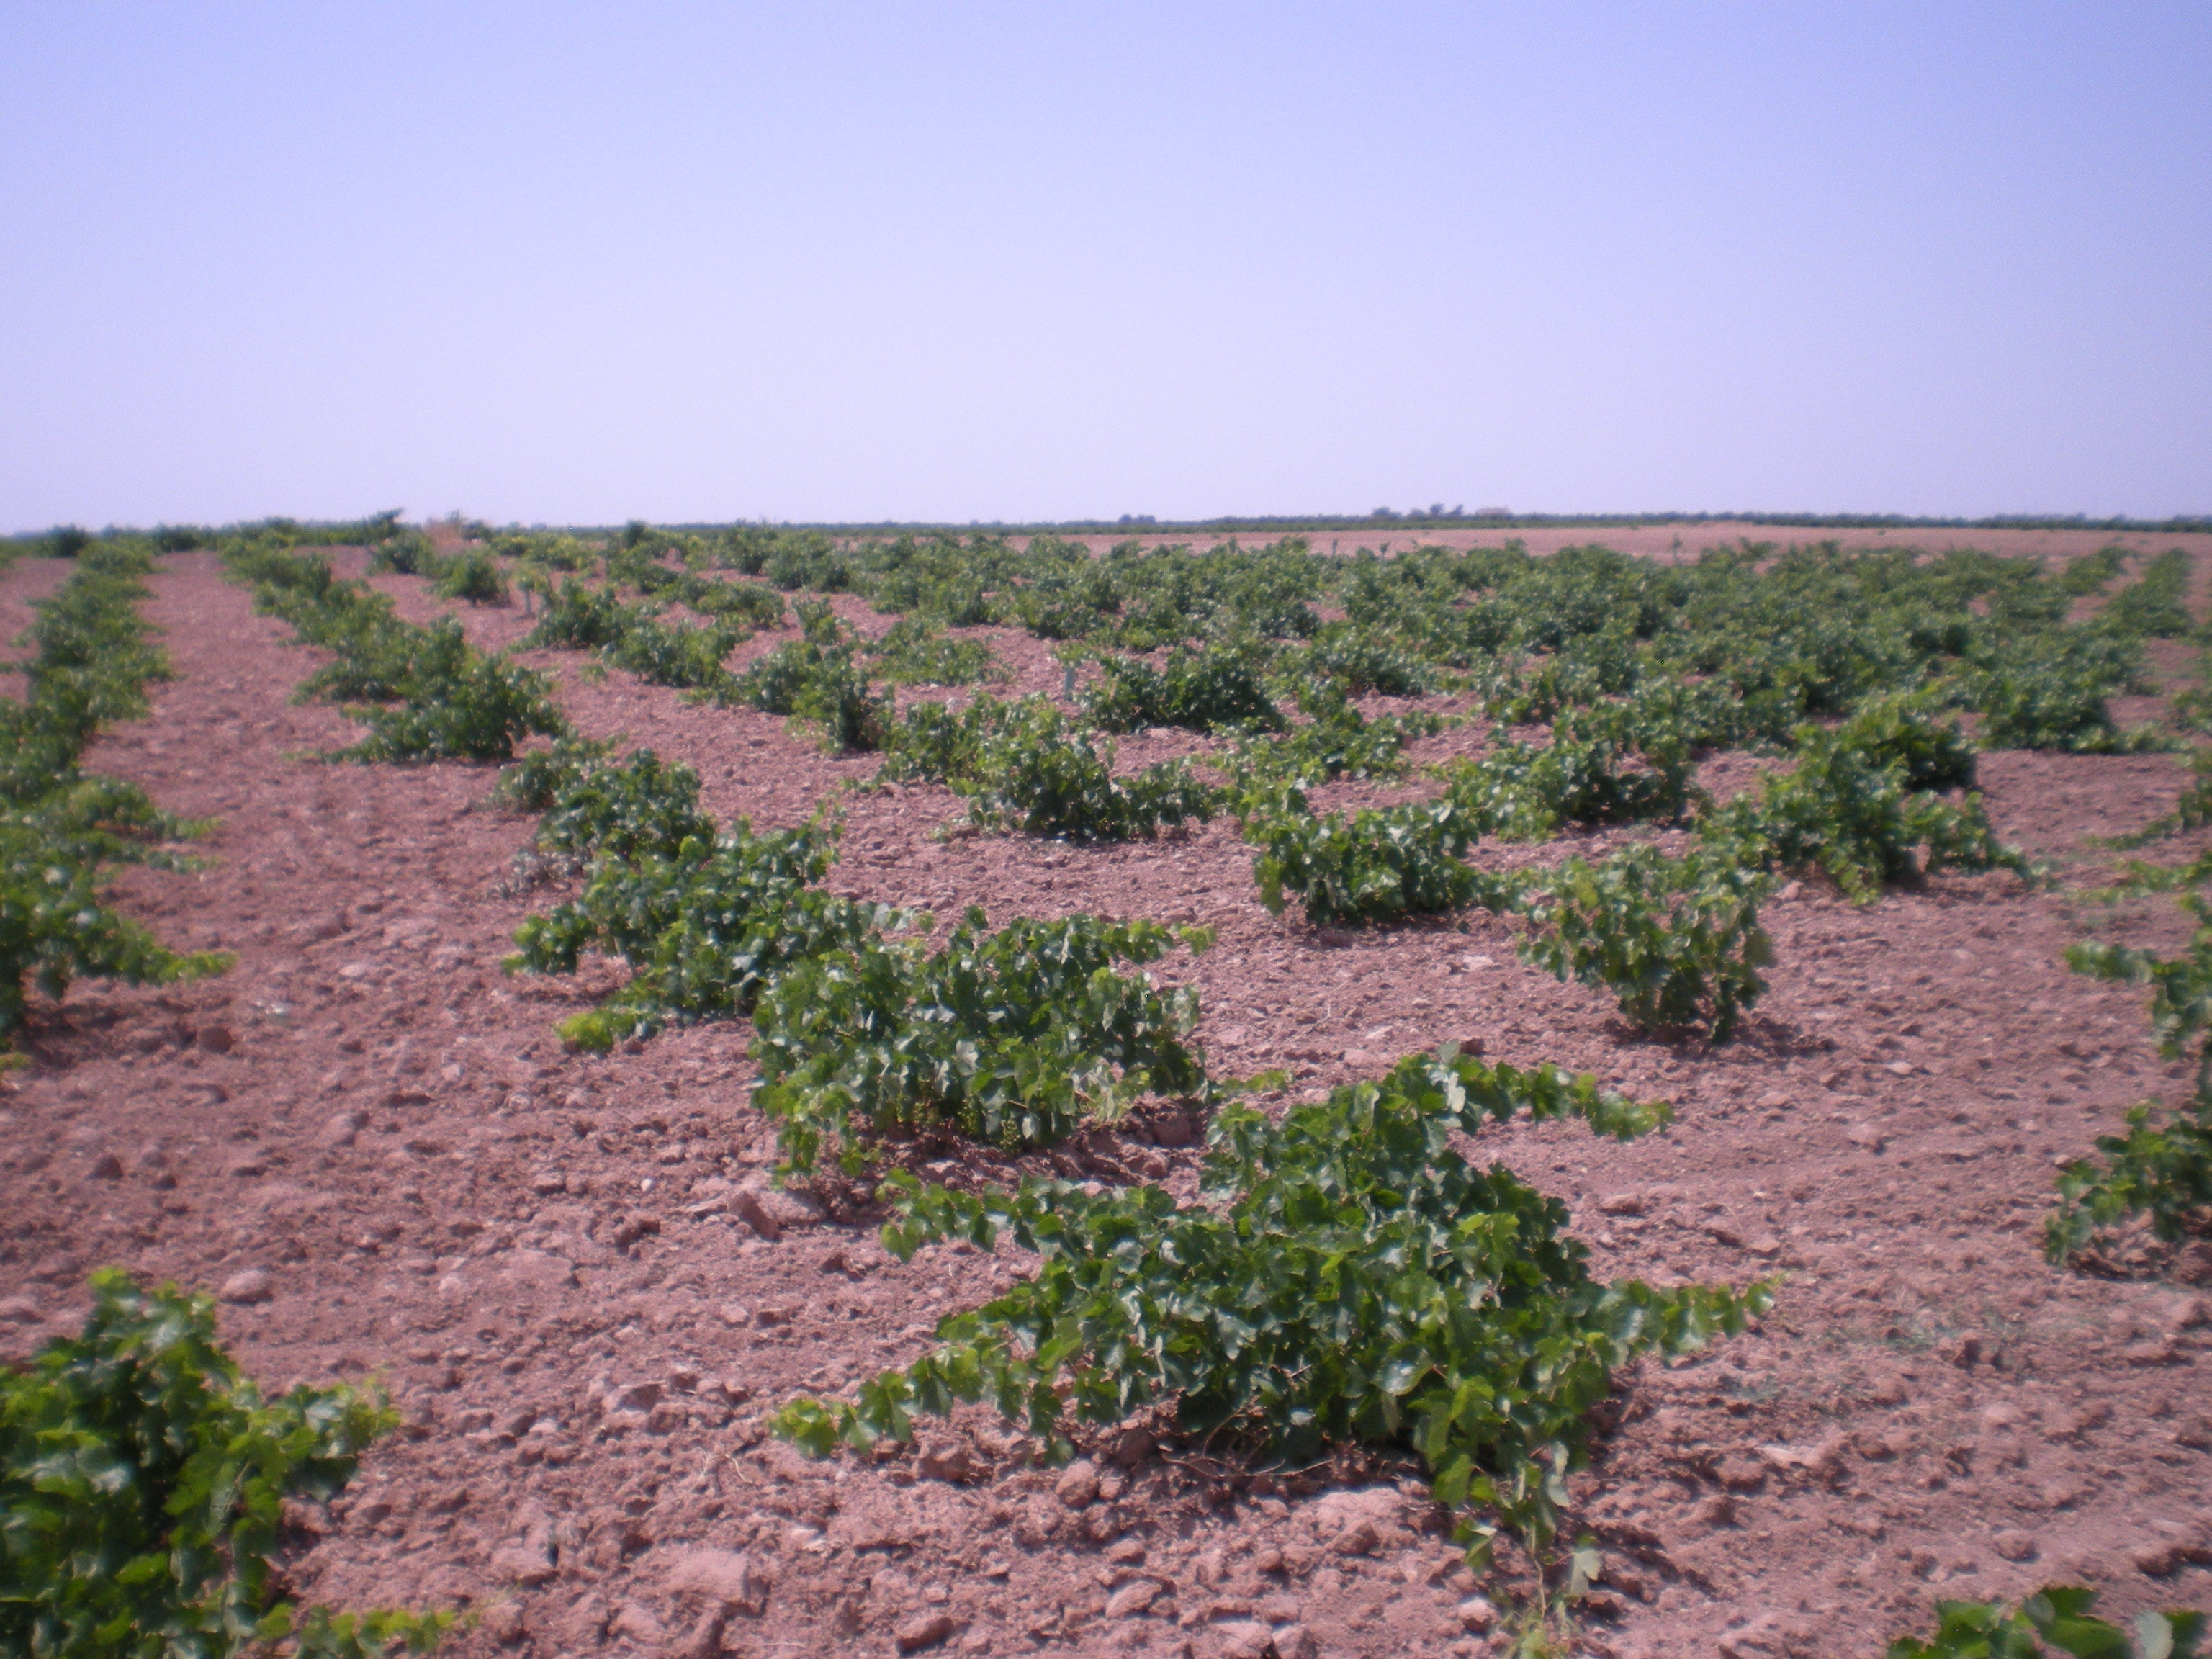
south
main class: Cropland
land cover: Vineyards
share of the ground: 10 - 25 %
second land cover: Other bare soil
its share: > 75 %
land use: Agriculture (excluding fallow land and kitchen gardens)
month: June
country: ES
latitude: 39.6310
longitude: -3.1745
